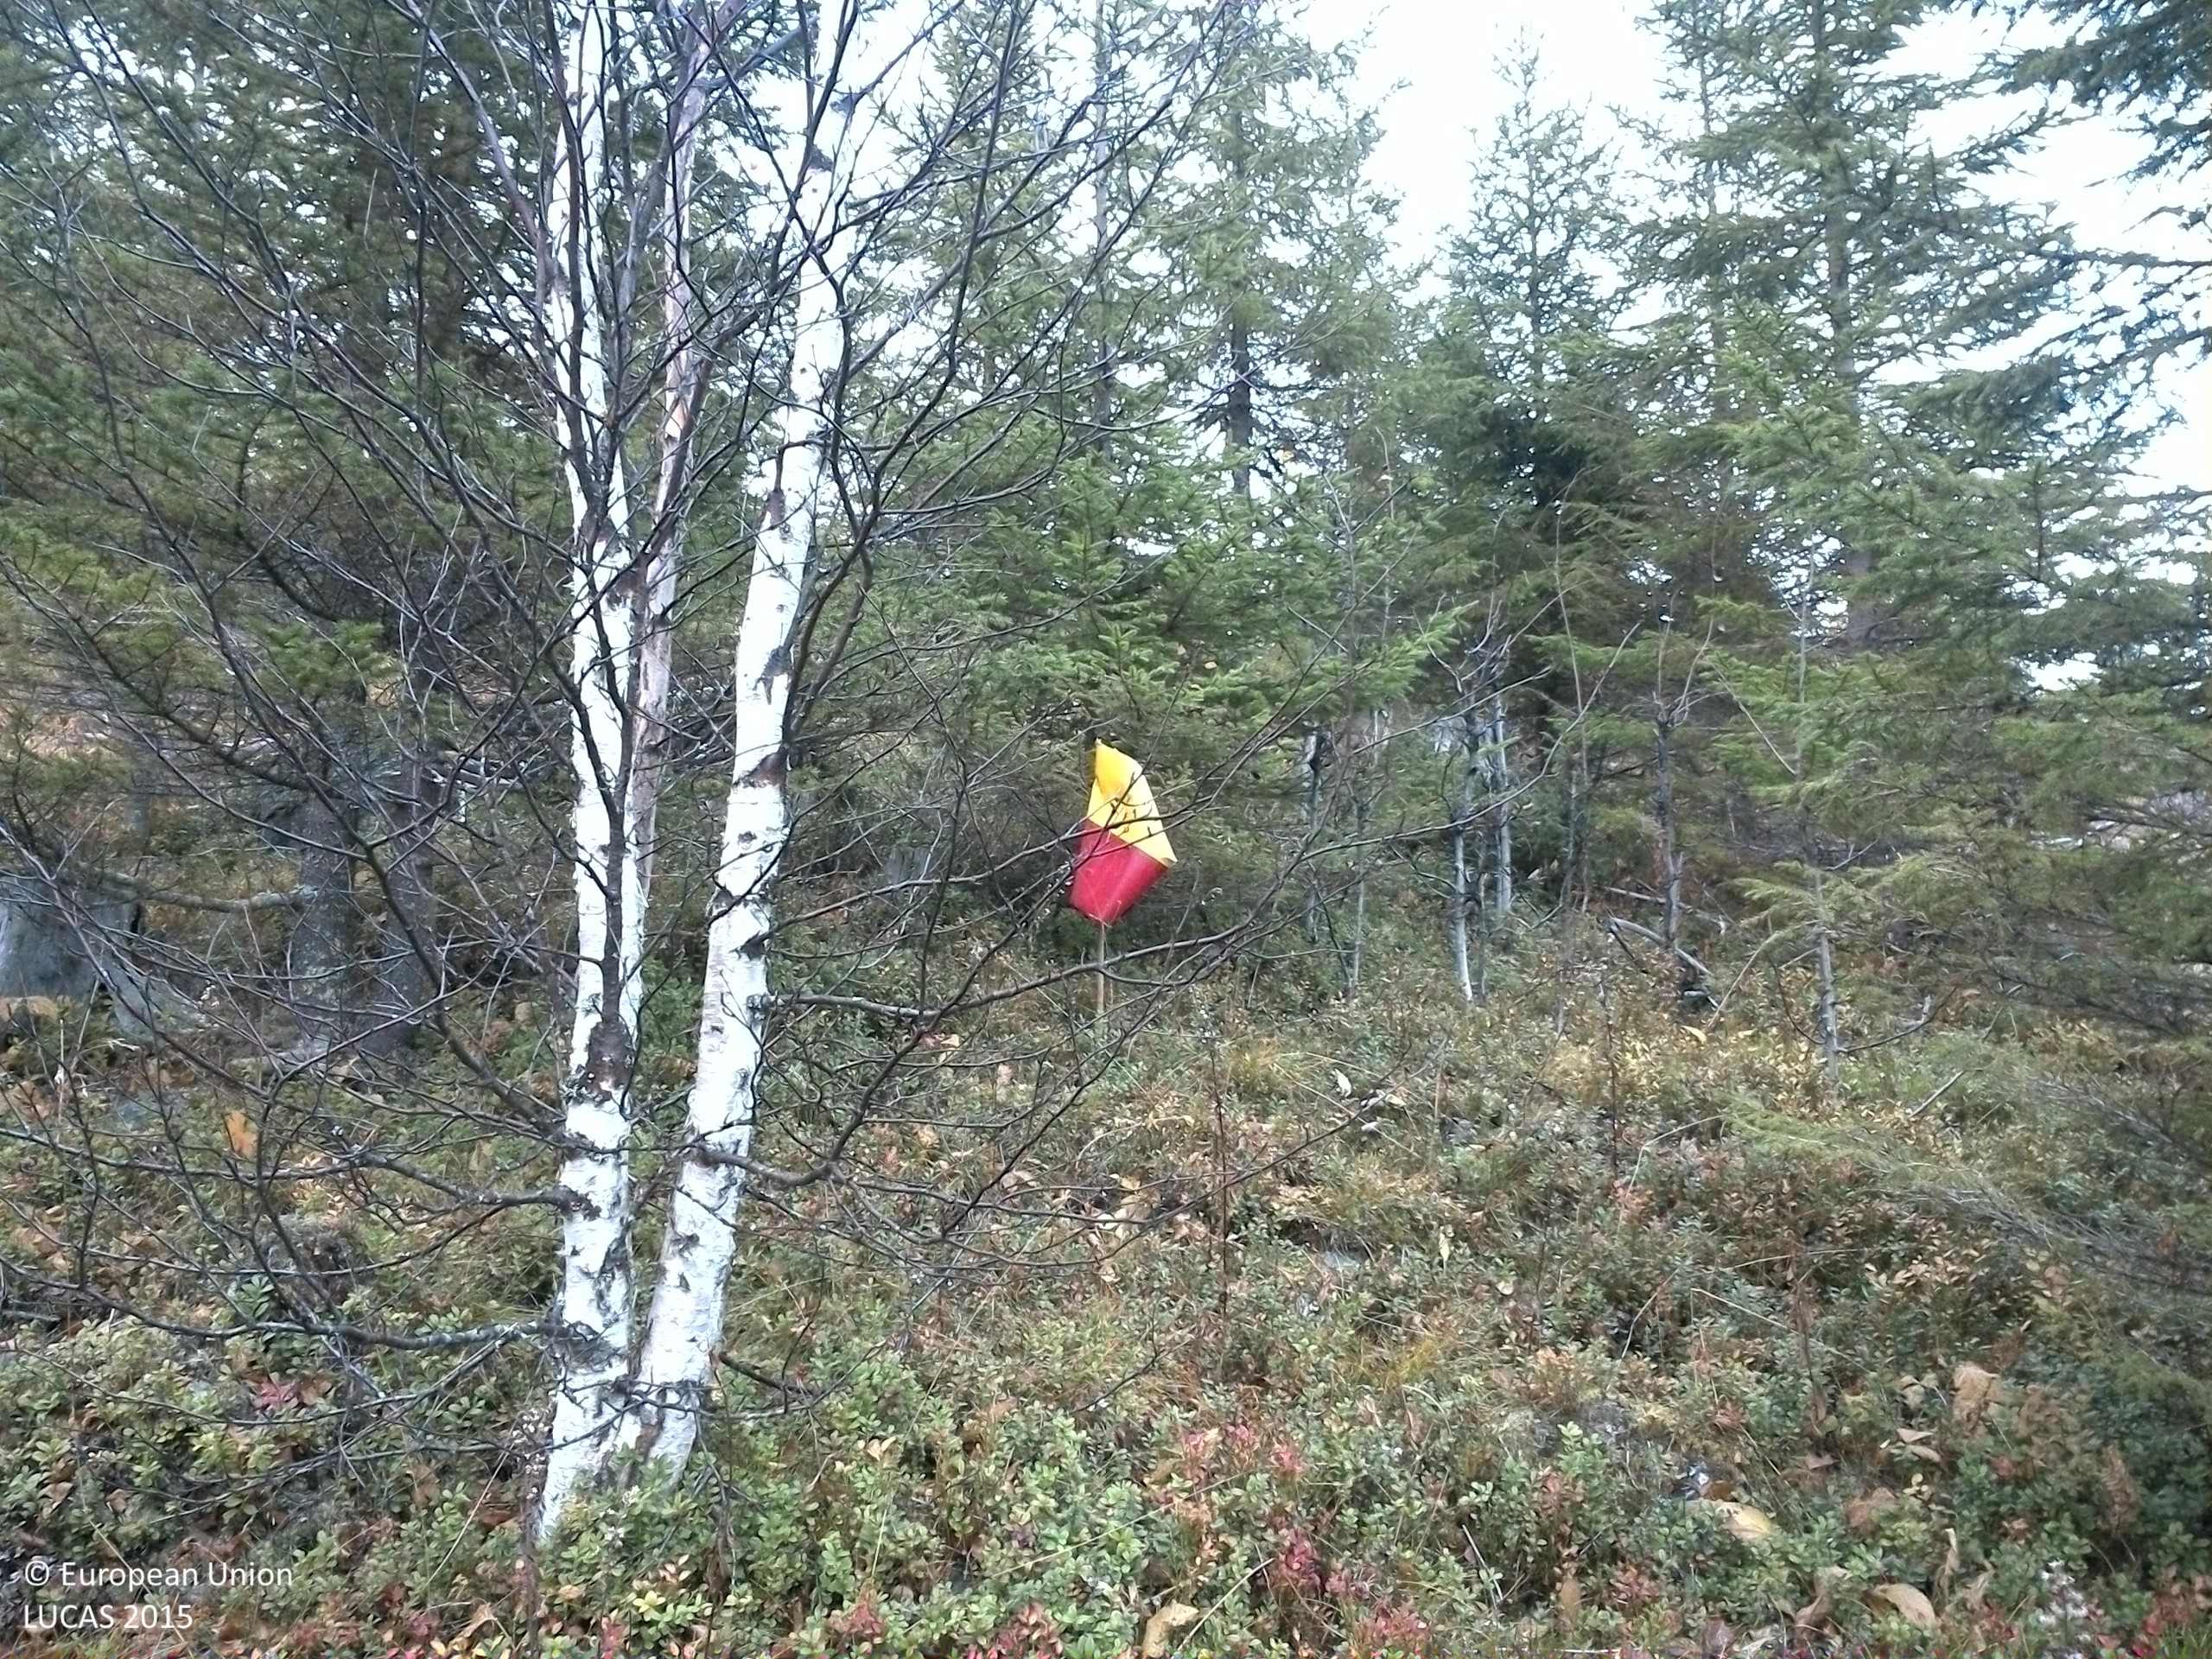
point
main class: Woodland
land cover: Spruce dominated mixed woodland
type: boreal forest
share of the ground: 50 - 75 %
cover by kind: coniferous forest trees 35 %, shrubs 35 %, broadleaved forest trees 15 %, lichens and mosses 10 %, consolidated bare surface 5 %
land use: Forestry
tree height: > 5 m
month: October
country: SE
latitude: 64.3449
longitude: 14.7554
